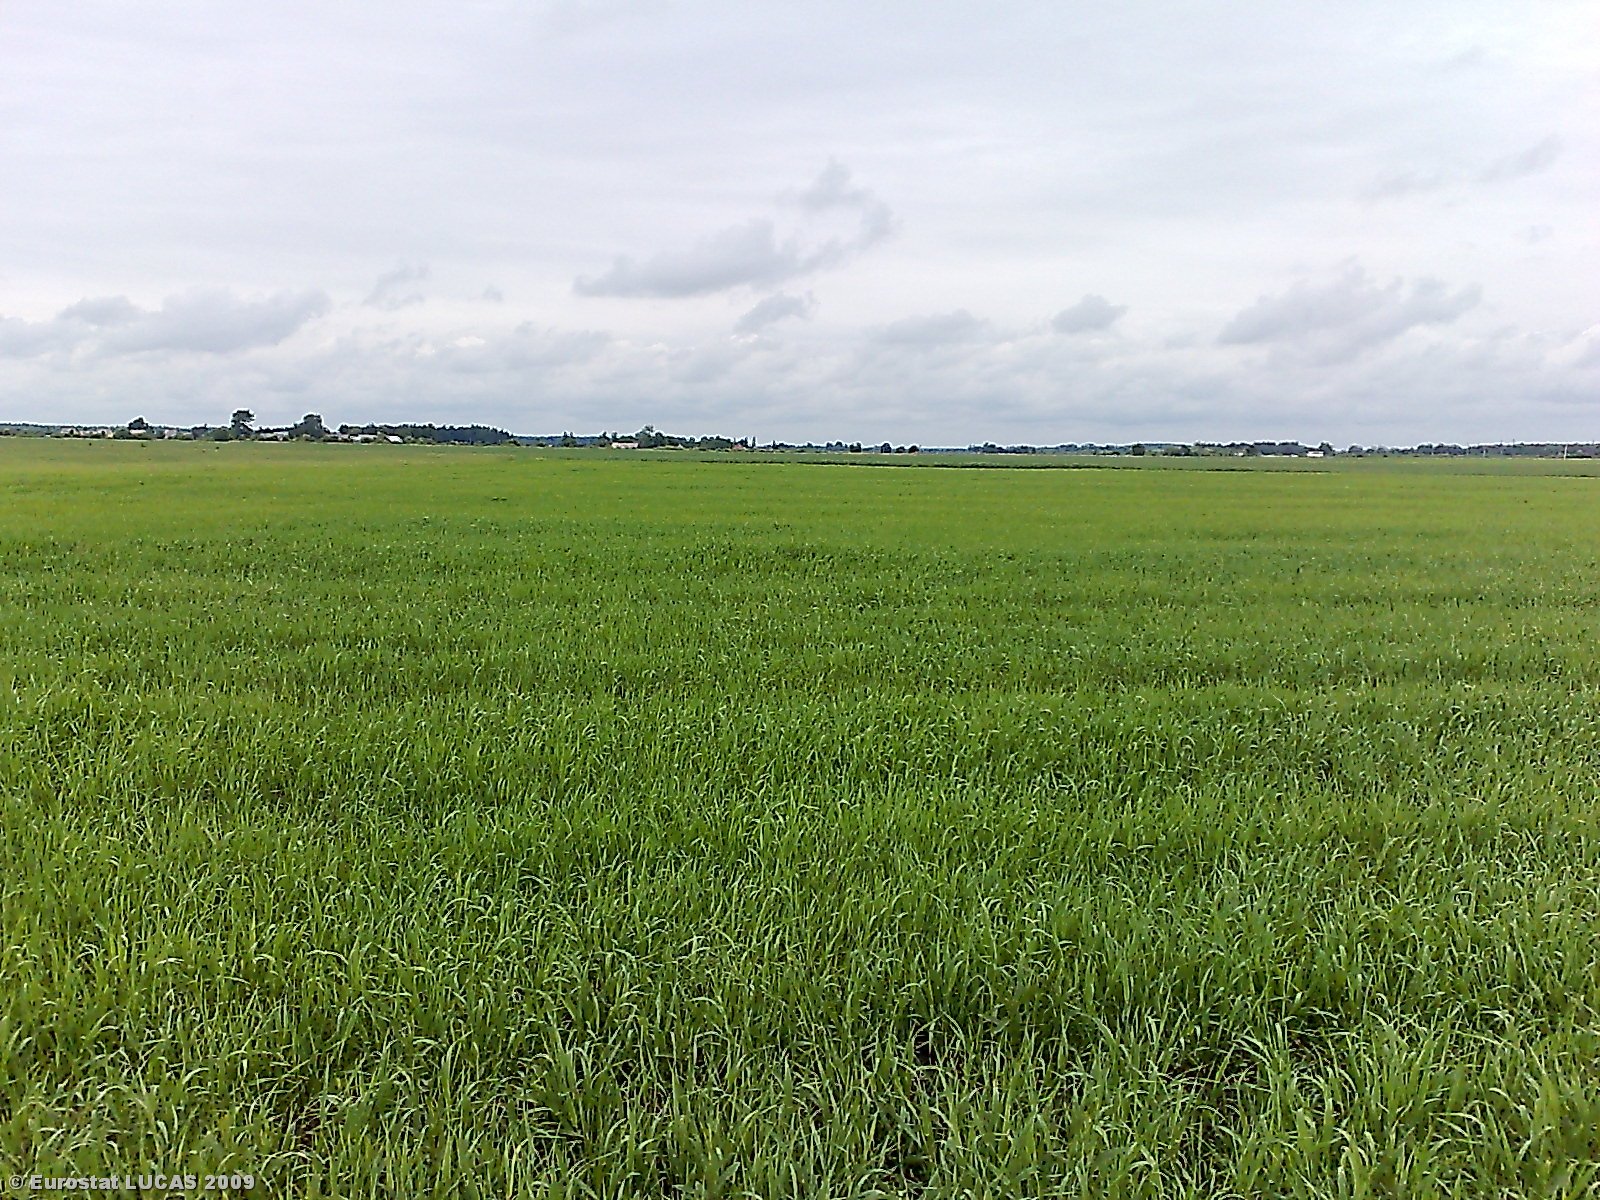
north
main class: Cropland
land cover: Barley
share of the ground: > 75 %
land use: Agriculture (excluding fallow land and kitchen gardens)
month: June
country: LT
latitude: 55.9695
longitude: 23.9454
